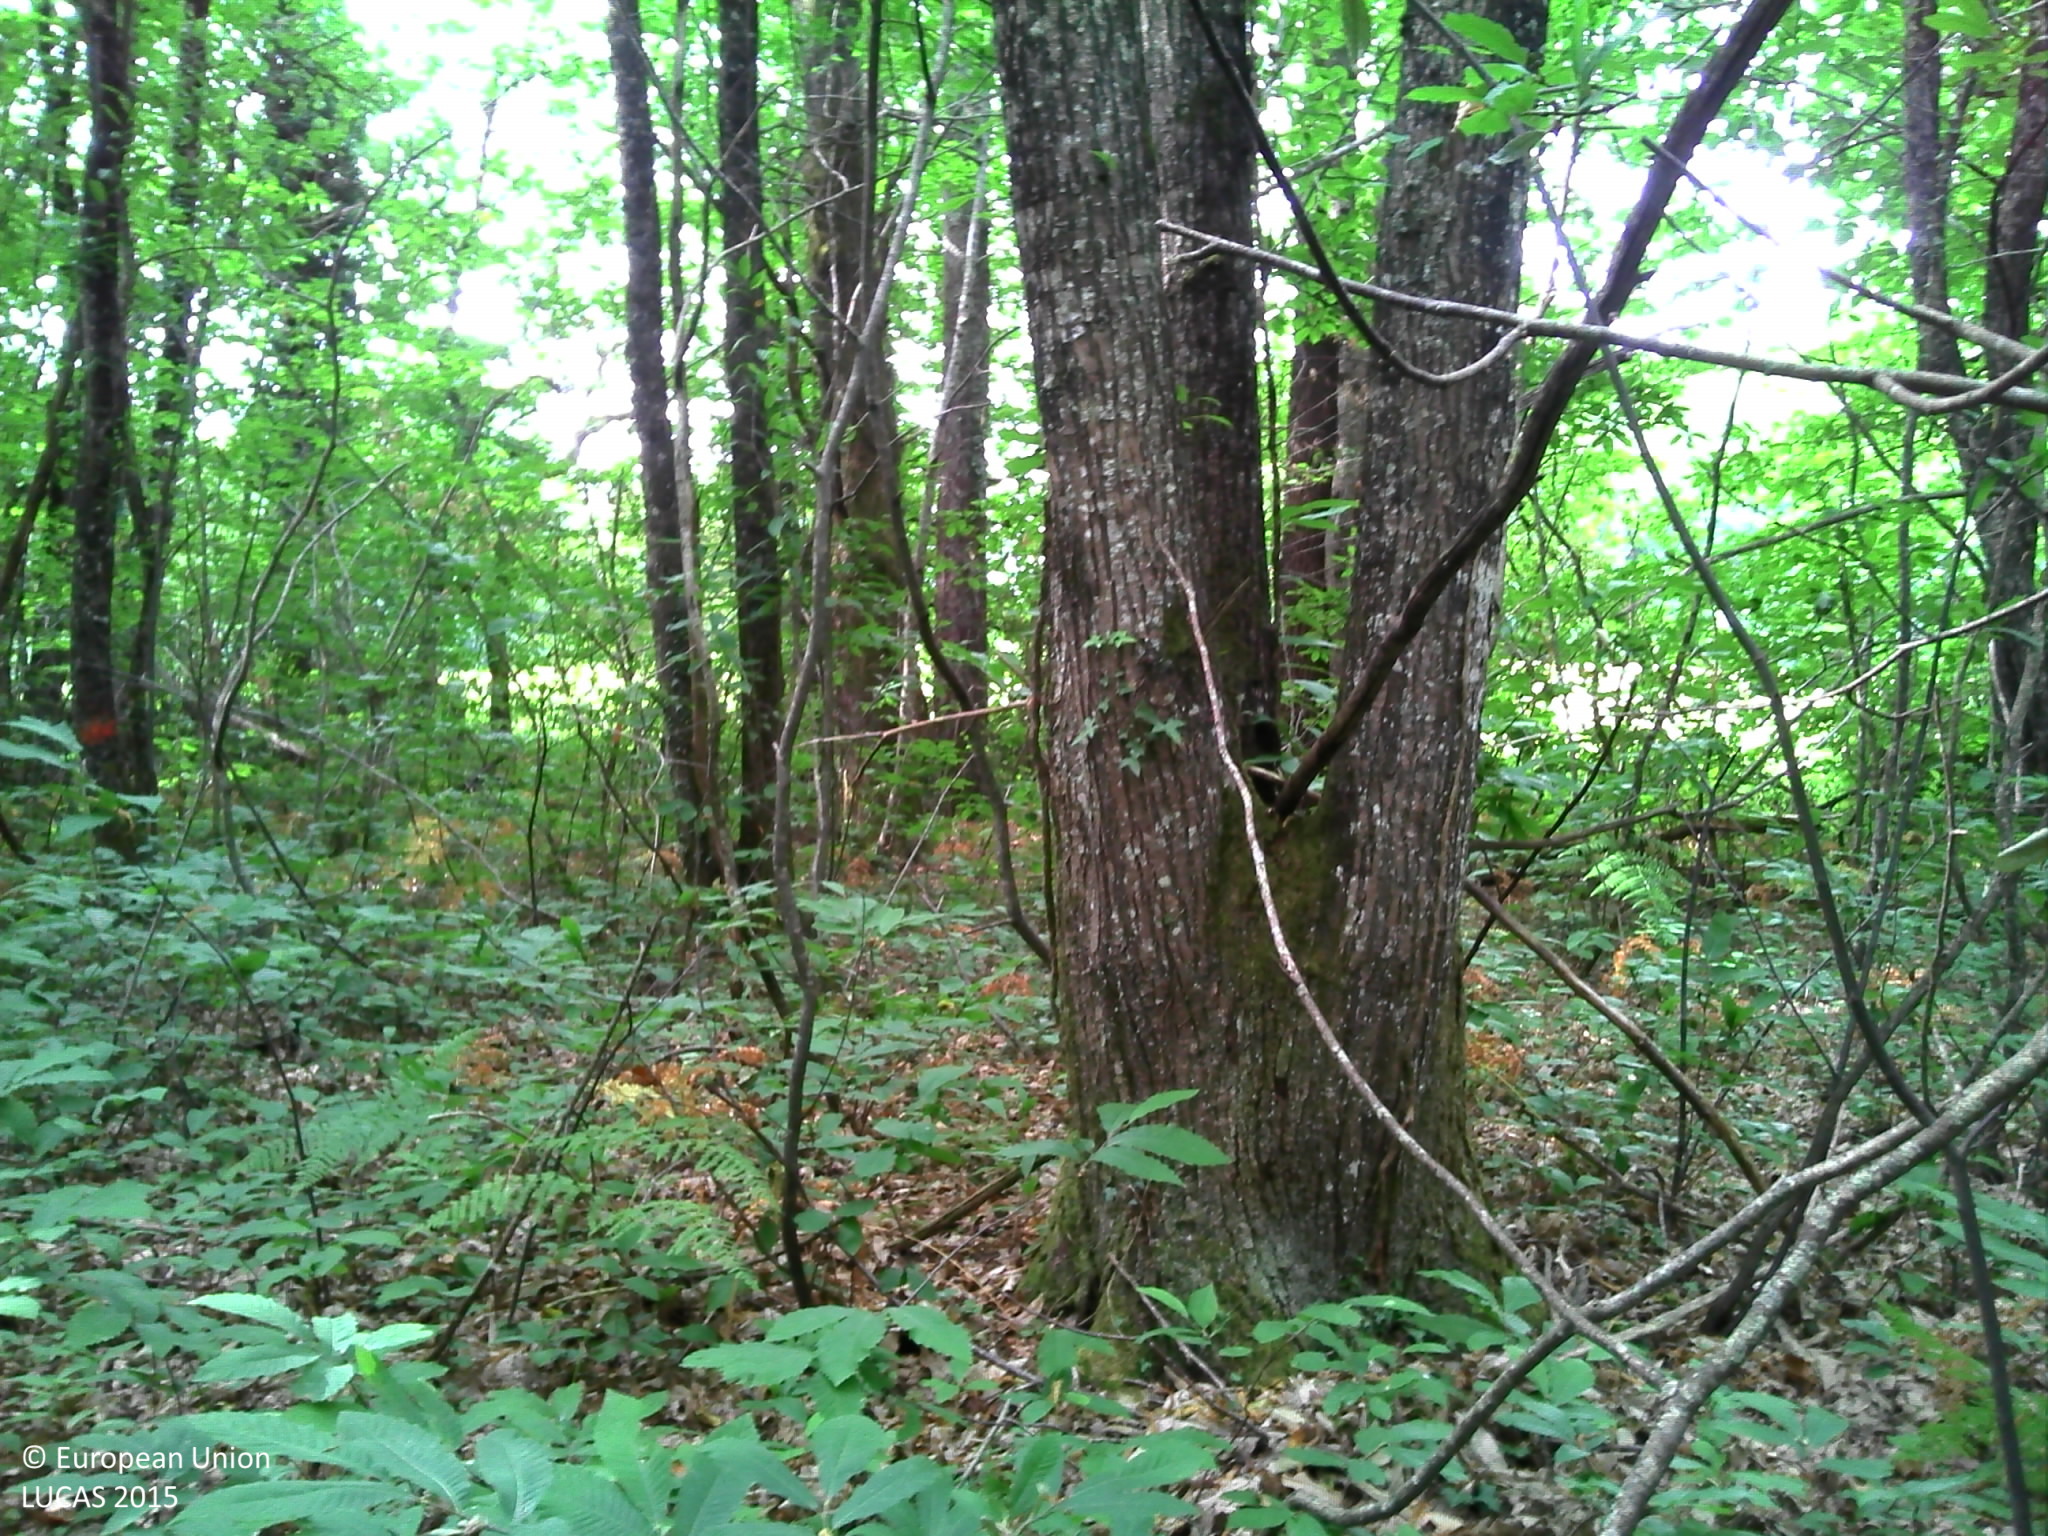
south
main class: Woodland
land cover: Broadleaved woodland
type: thermophilous deciduous forest
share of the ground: > 75 %
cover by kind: broadleaved forest trees 80 %, herbaceous plants 10 %, shrubs 5 %, lichens and mosses 5 %
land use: Forestry
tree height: > 5 m
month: July
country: FR
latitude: 44.9906
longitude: 0.7703
